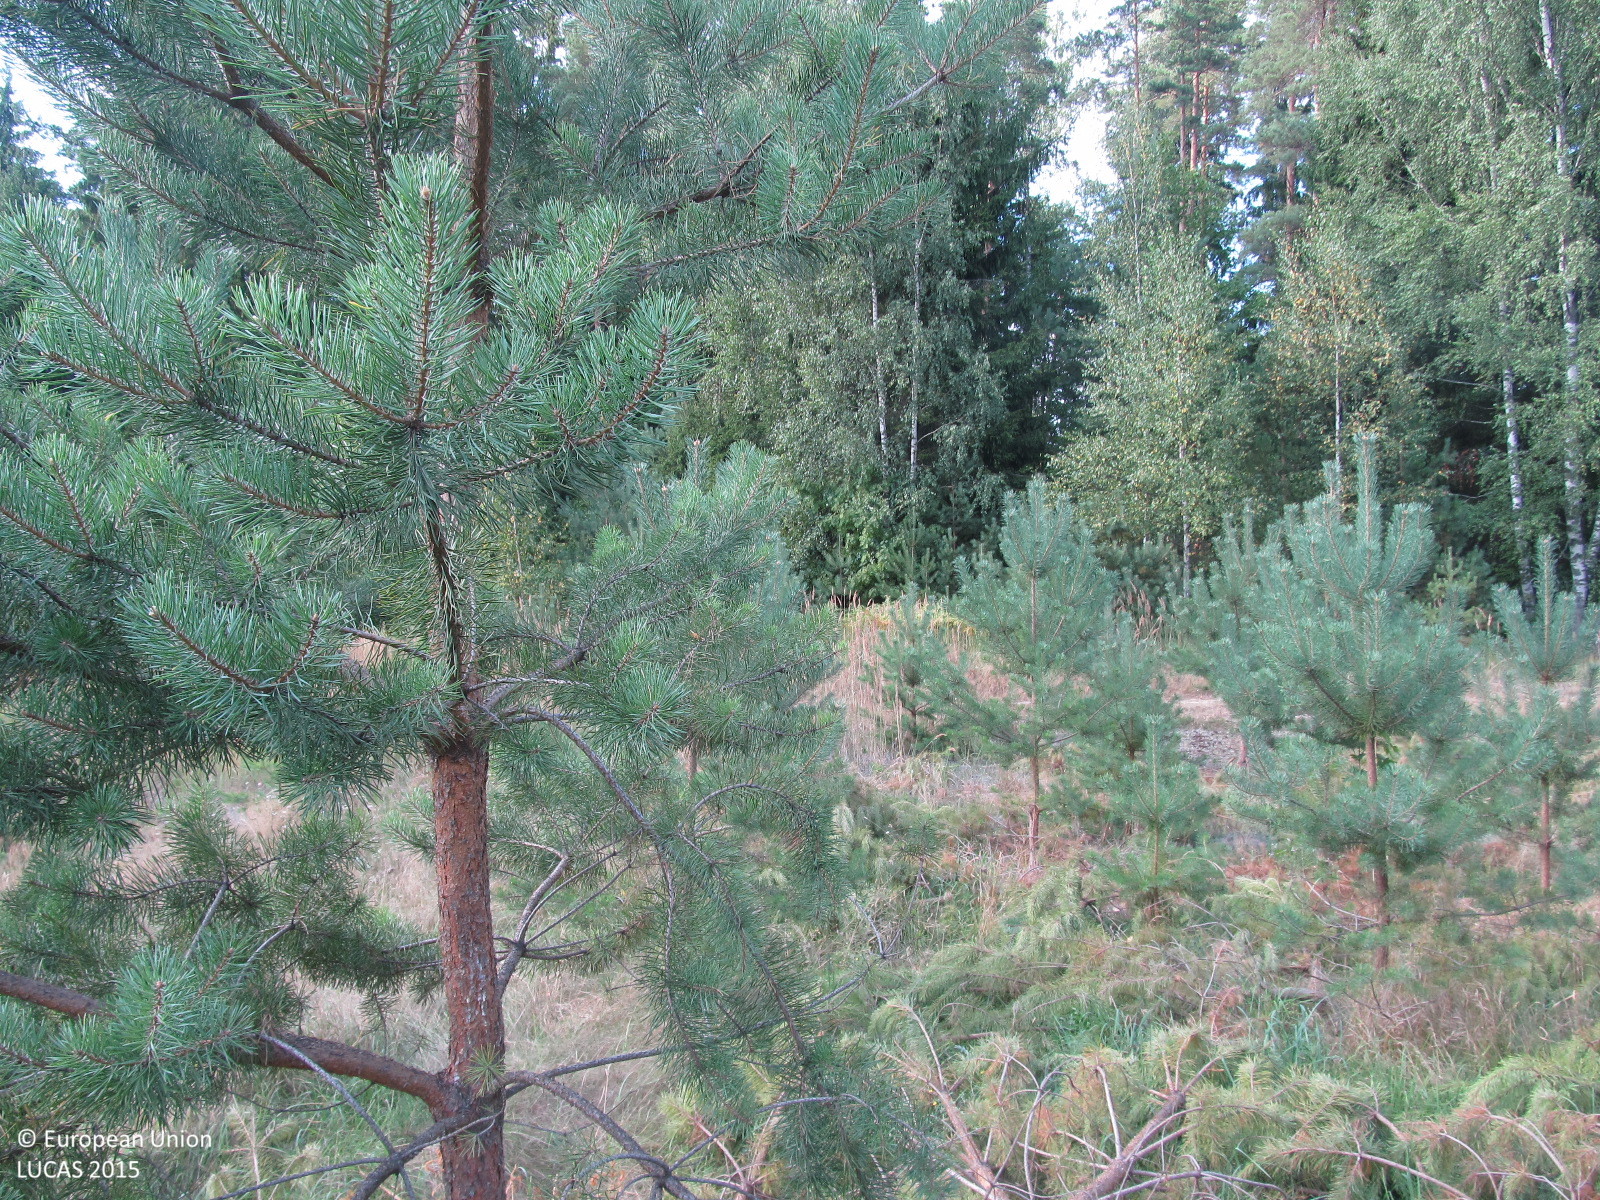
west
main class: Woodland
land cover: Pine dominated coniferous woodland
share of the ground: 25 - 50 %
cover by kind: herbaceous plants 70 %, coniferous forest trees 30 %
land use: Forestry
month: August
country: LT
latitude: 55.8214
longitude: 23.1107
